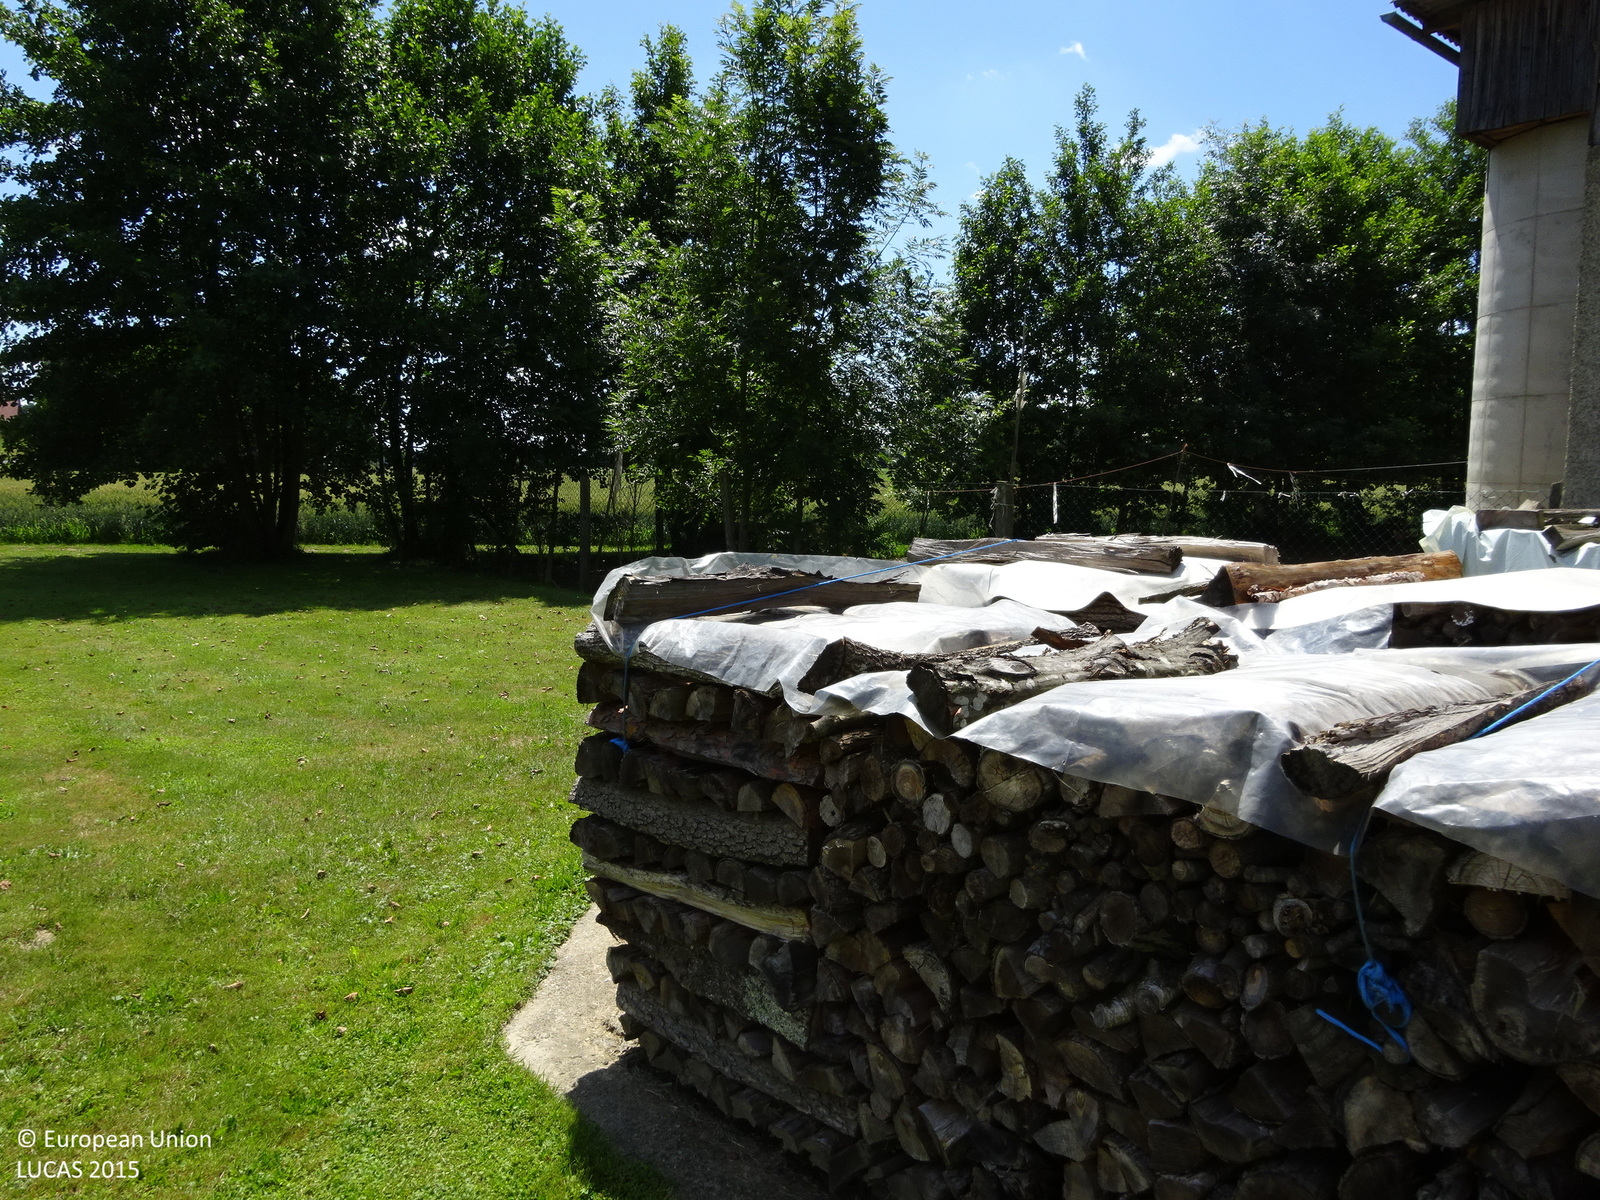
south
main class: Grassland
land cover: Grassland without tree/shrub cover
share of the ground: > 75 %
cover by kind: herbaceous plants 100 %
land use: Agriculture (excluding fallow land and kitchen gardens)
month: June
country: AT
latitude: 46.7644
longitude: 15.9317
